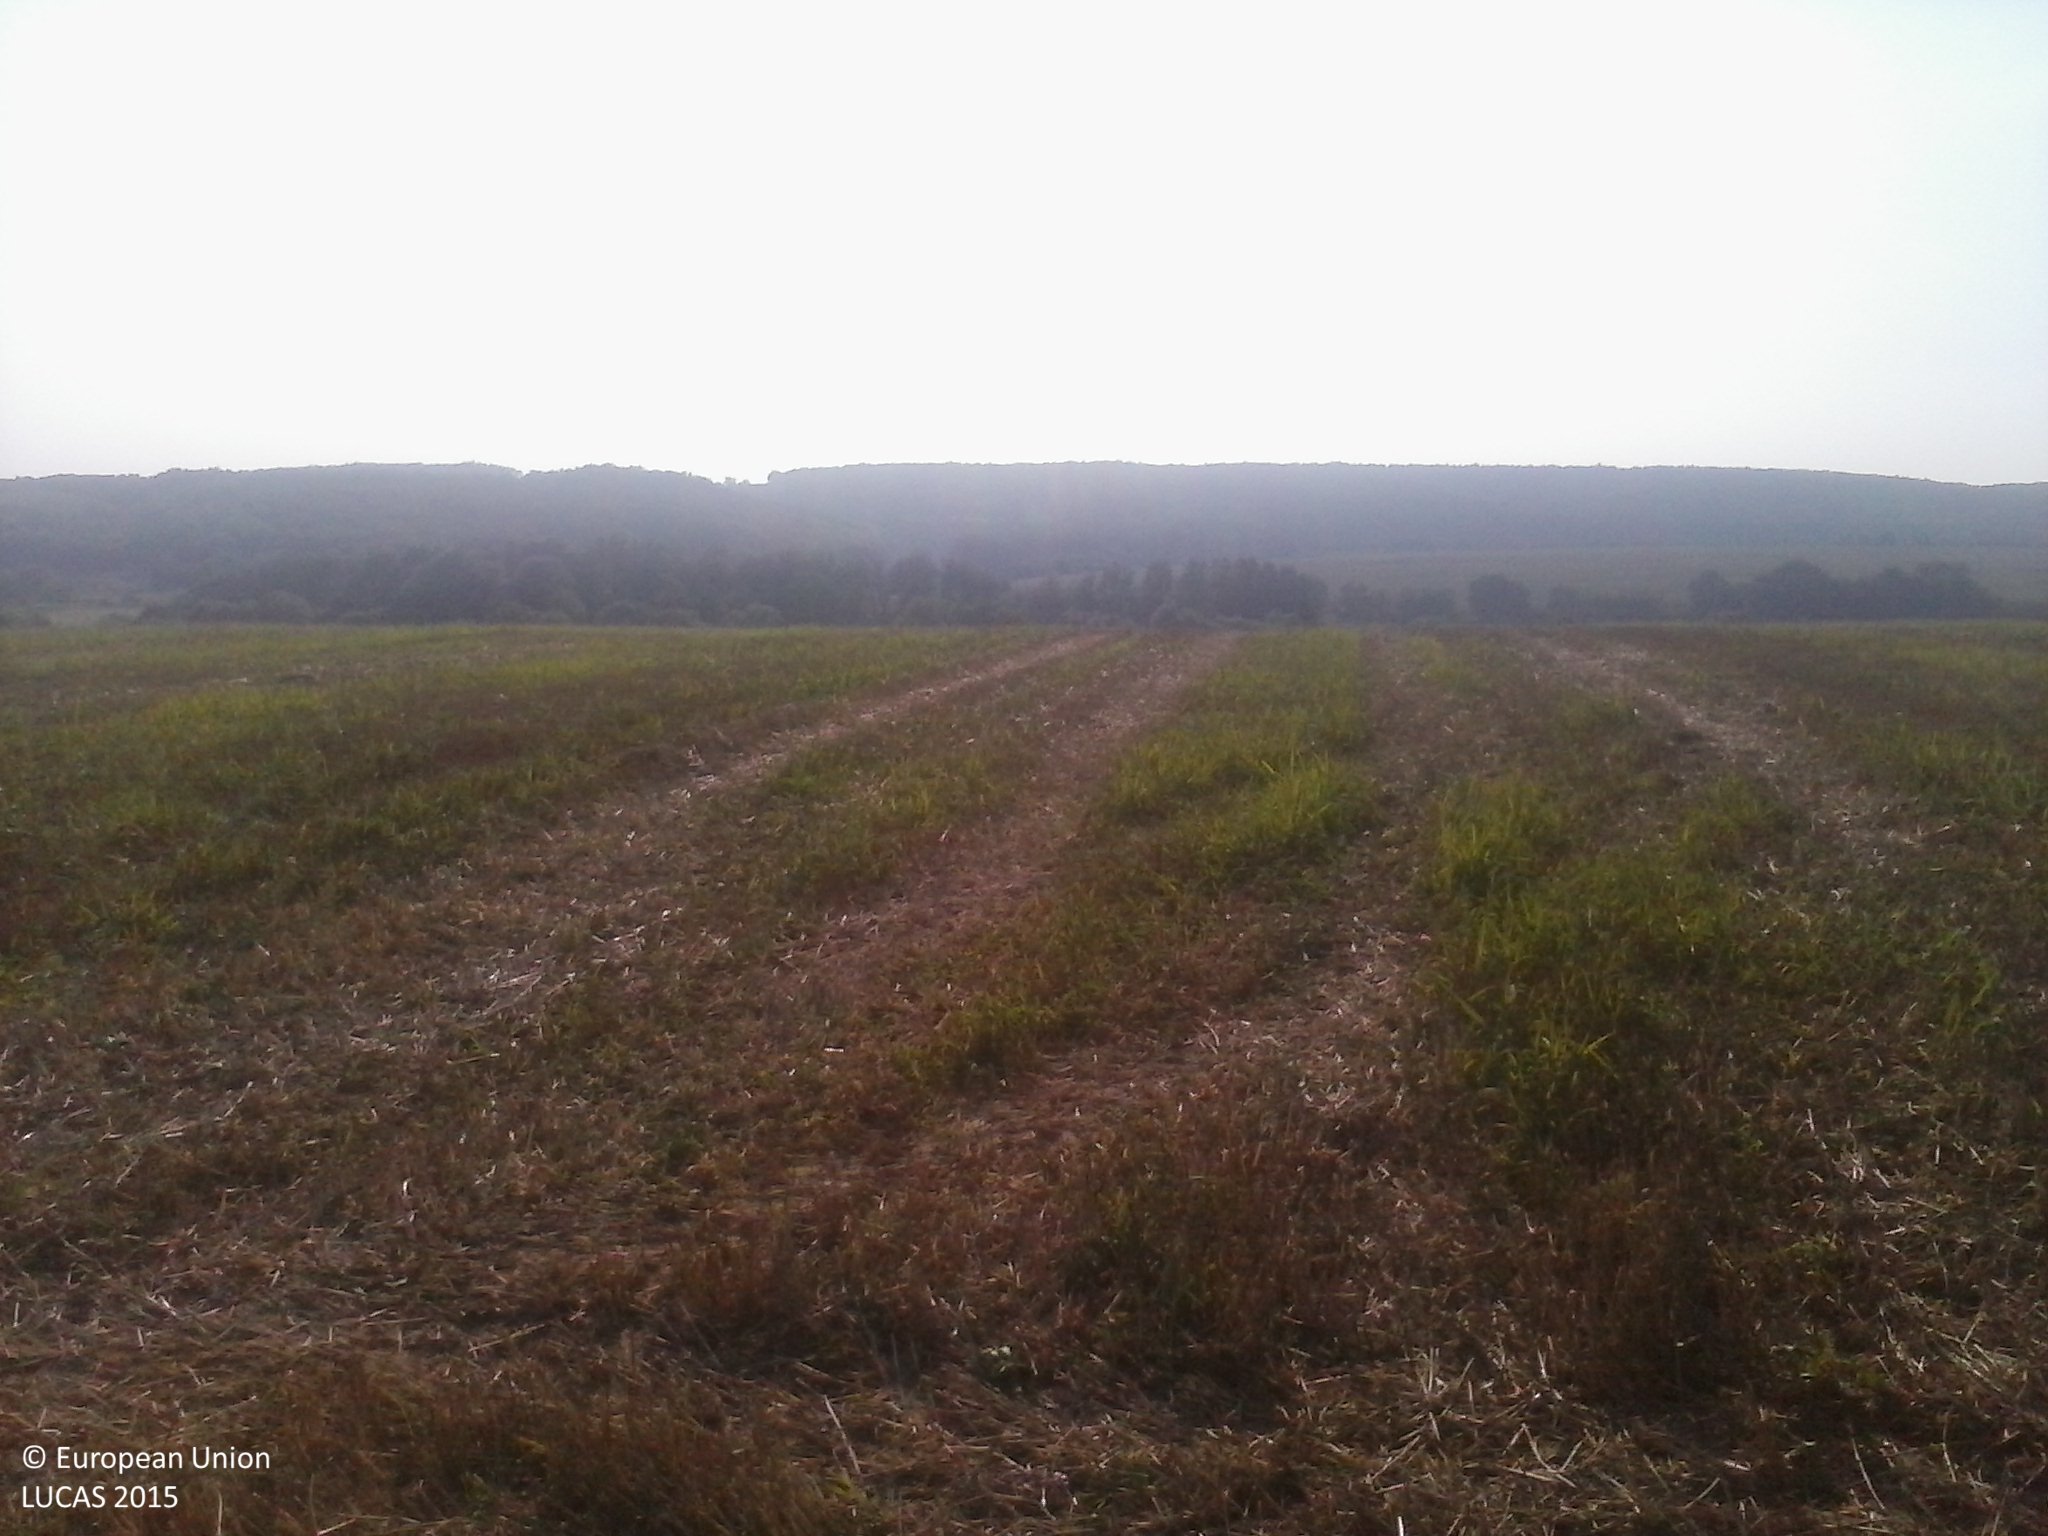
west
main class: Cropland
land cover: Common wheat
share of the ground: > 75 %
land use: Agriculture (excluding fallow land and kitchen gardens)
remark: Harvested field
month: August
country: HU
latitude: 46.1414
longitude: 17.7593
